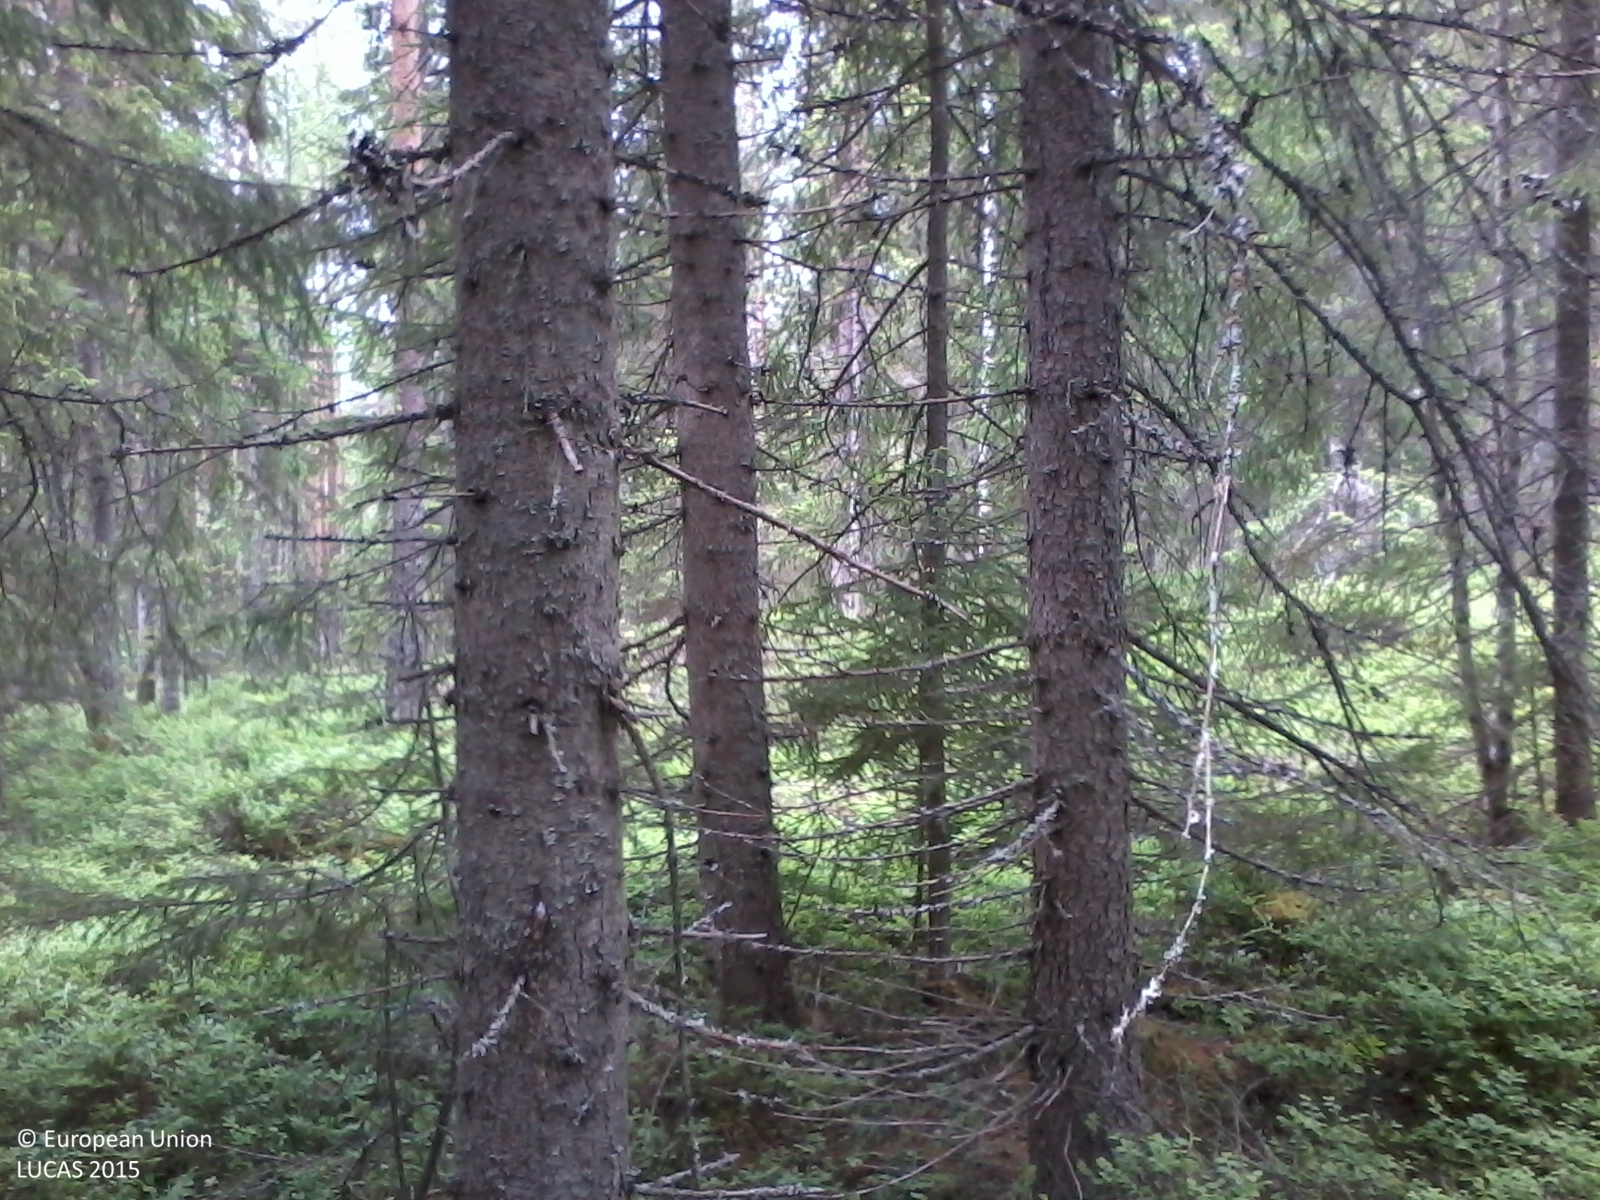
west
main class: Woodland
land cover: Spruce dominated mixed woodland
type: boreal forest
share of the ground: 50 - 75 %
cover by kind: coniferous forest trees 50 %, shrubs 30 %, broadleaved forest trees 20 %
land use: Forestry
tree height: > 5 m
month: June
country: SE
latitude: 63.4688
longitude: 18.0215
